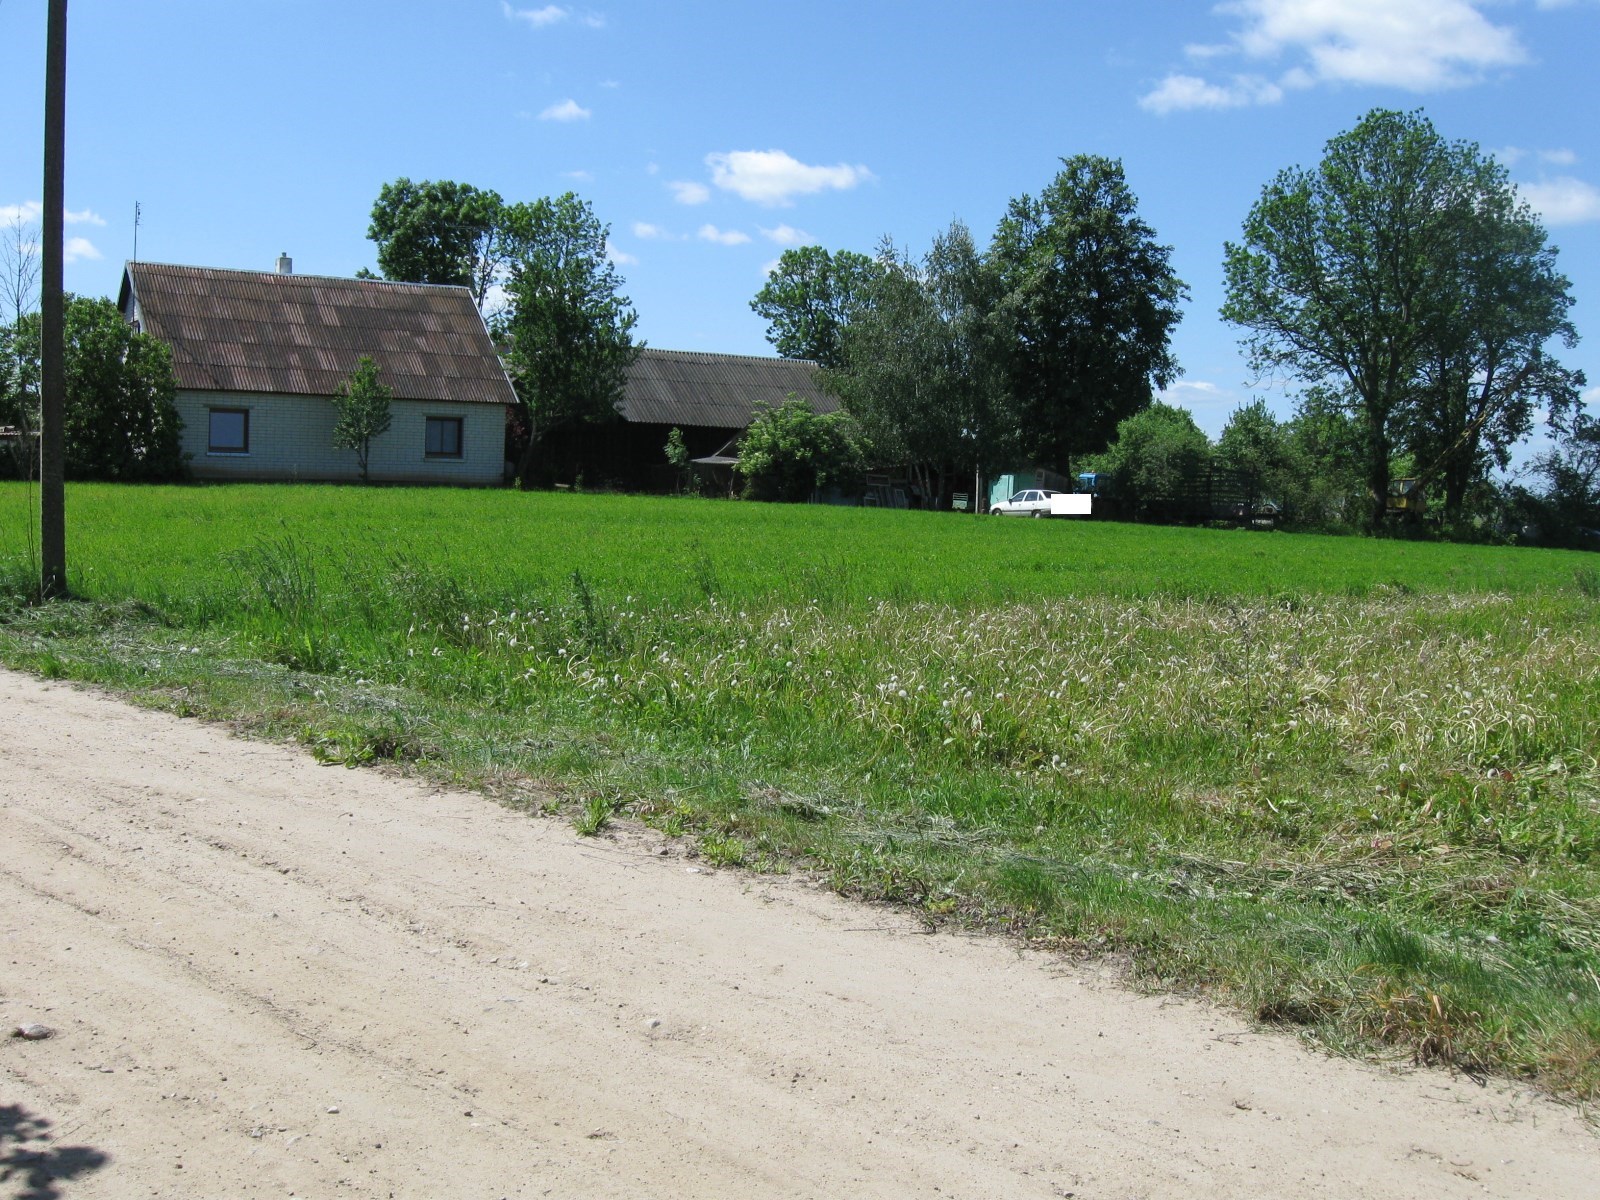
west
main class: Cropland
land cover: Apple fruit
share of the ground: 50 - 75 %
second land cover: Shrubland without tree cover
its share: 50 - 75 %
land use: Kitchen garden
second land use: Residential
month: June
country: LT
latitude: 54.3913
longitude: 23.8417
